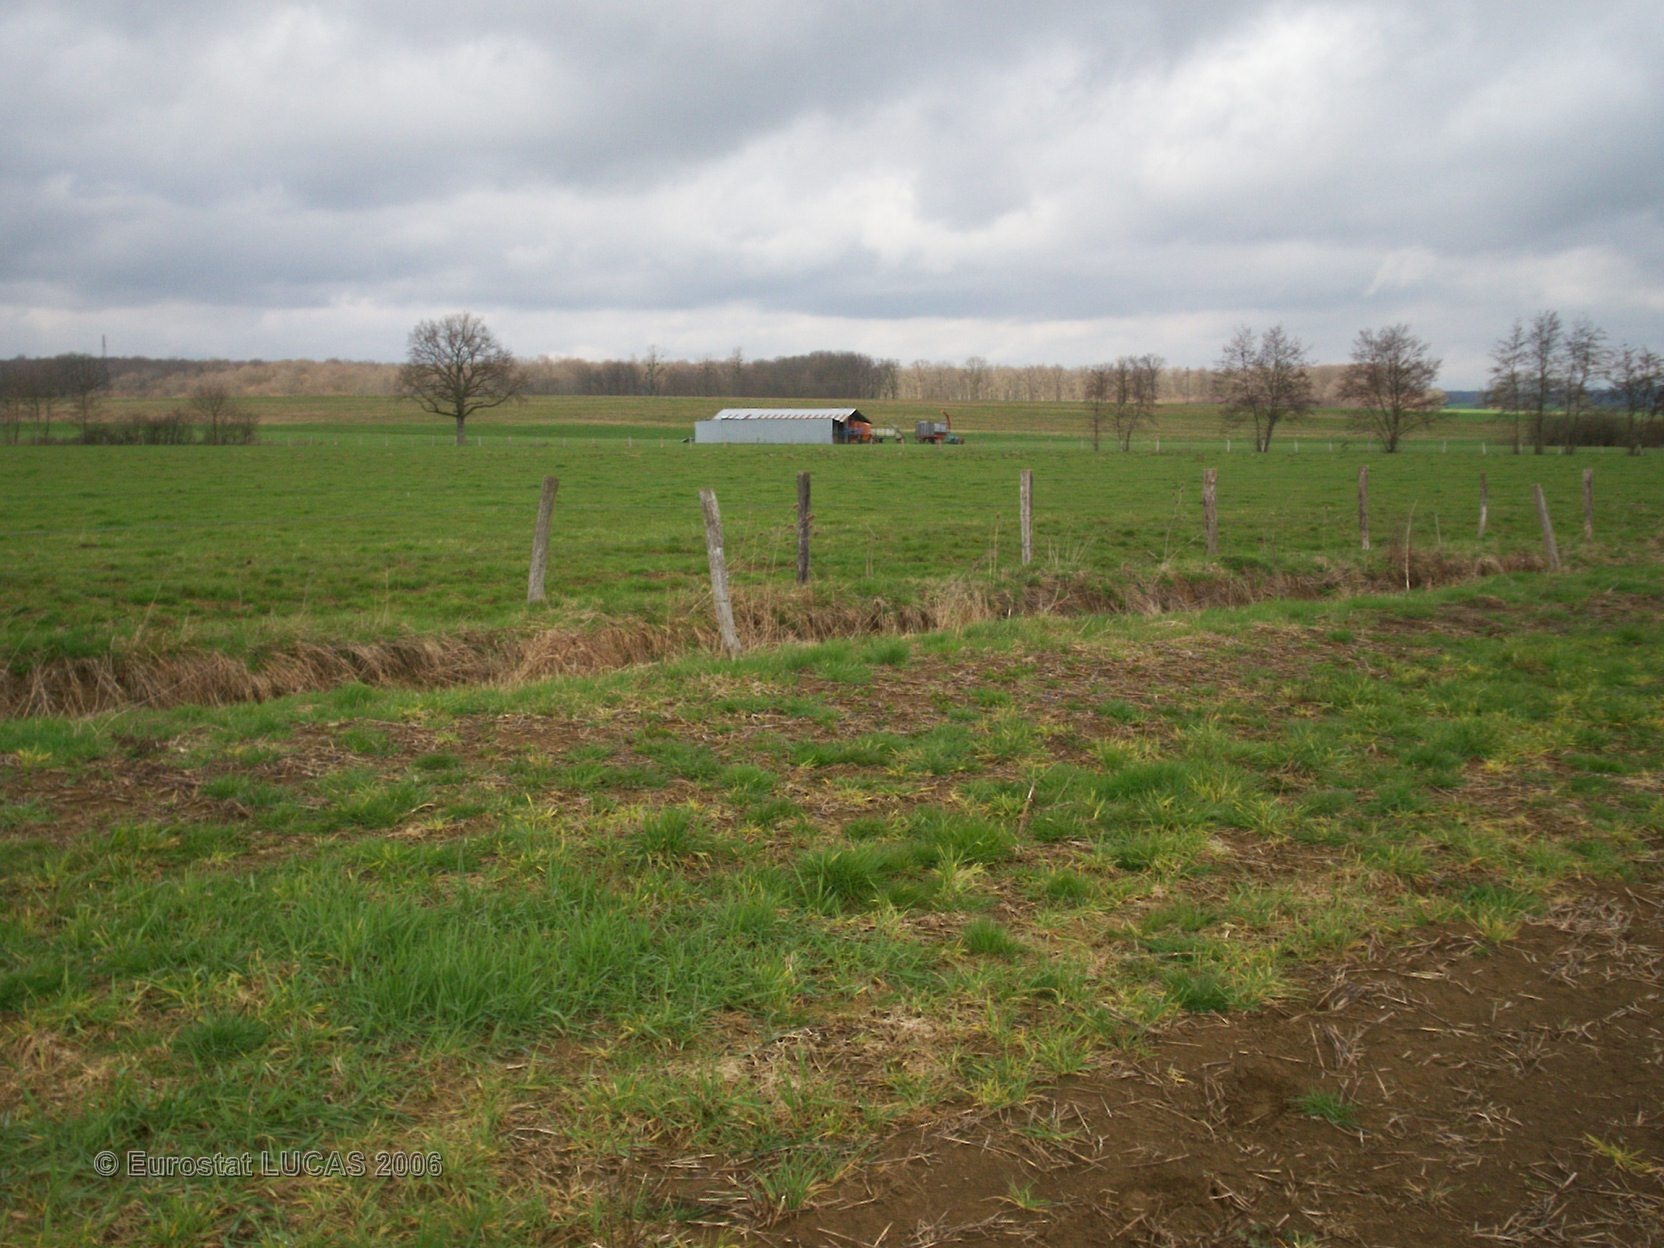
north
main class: Cropland
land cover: Maize
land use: Agriculture (excluding fallow land and kitchen gardens)
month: May
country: FR
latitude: 47.6233
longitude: 6.3688
